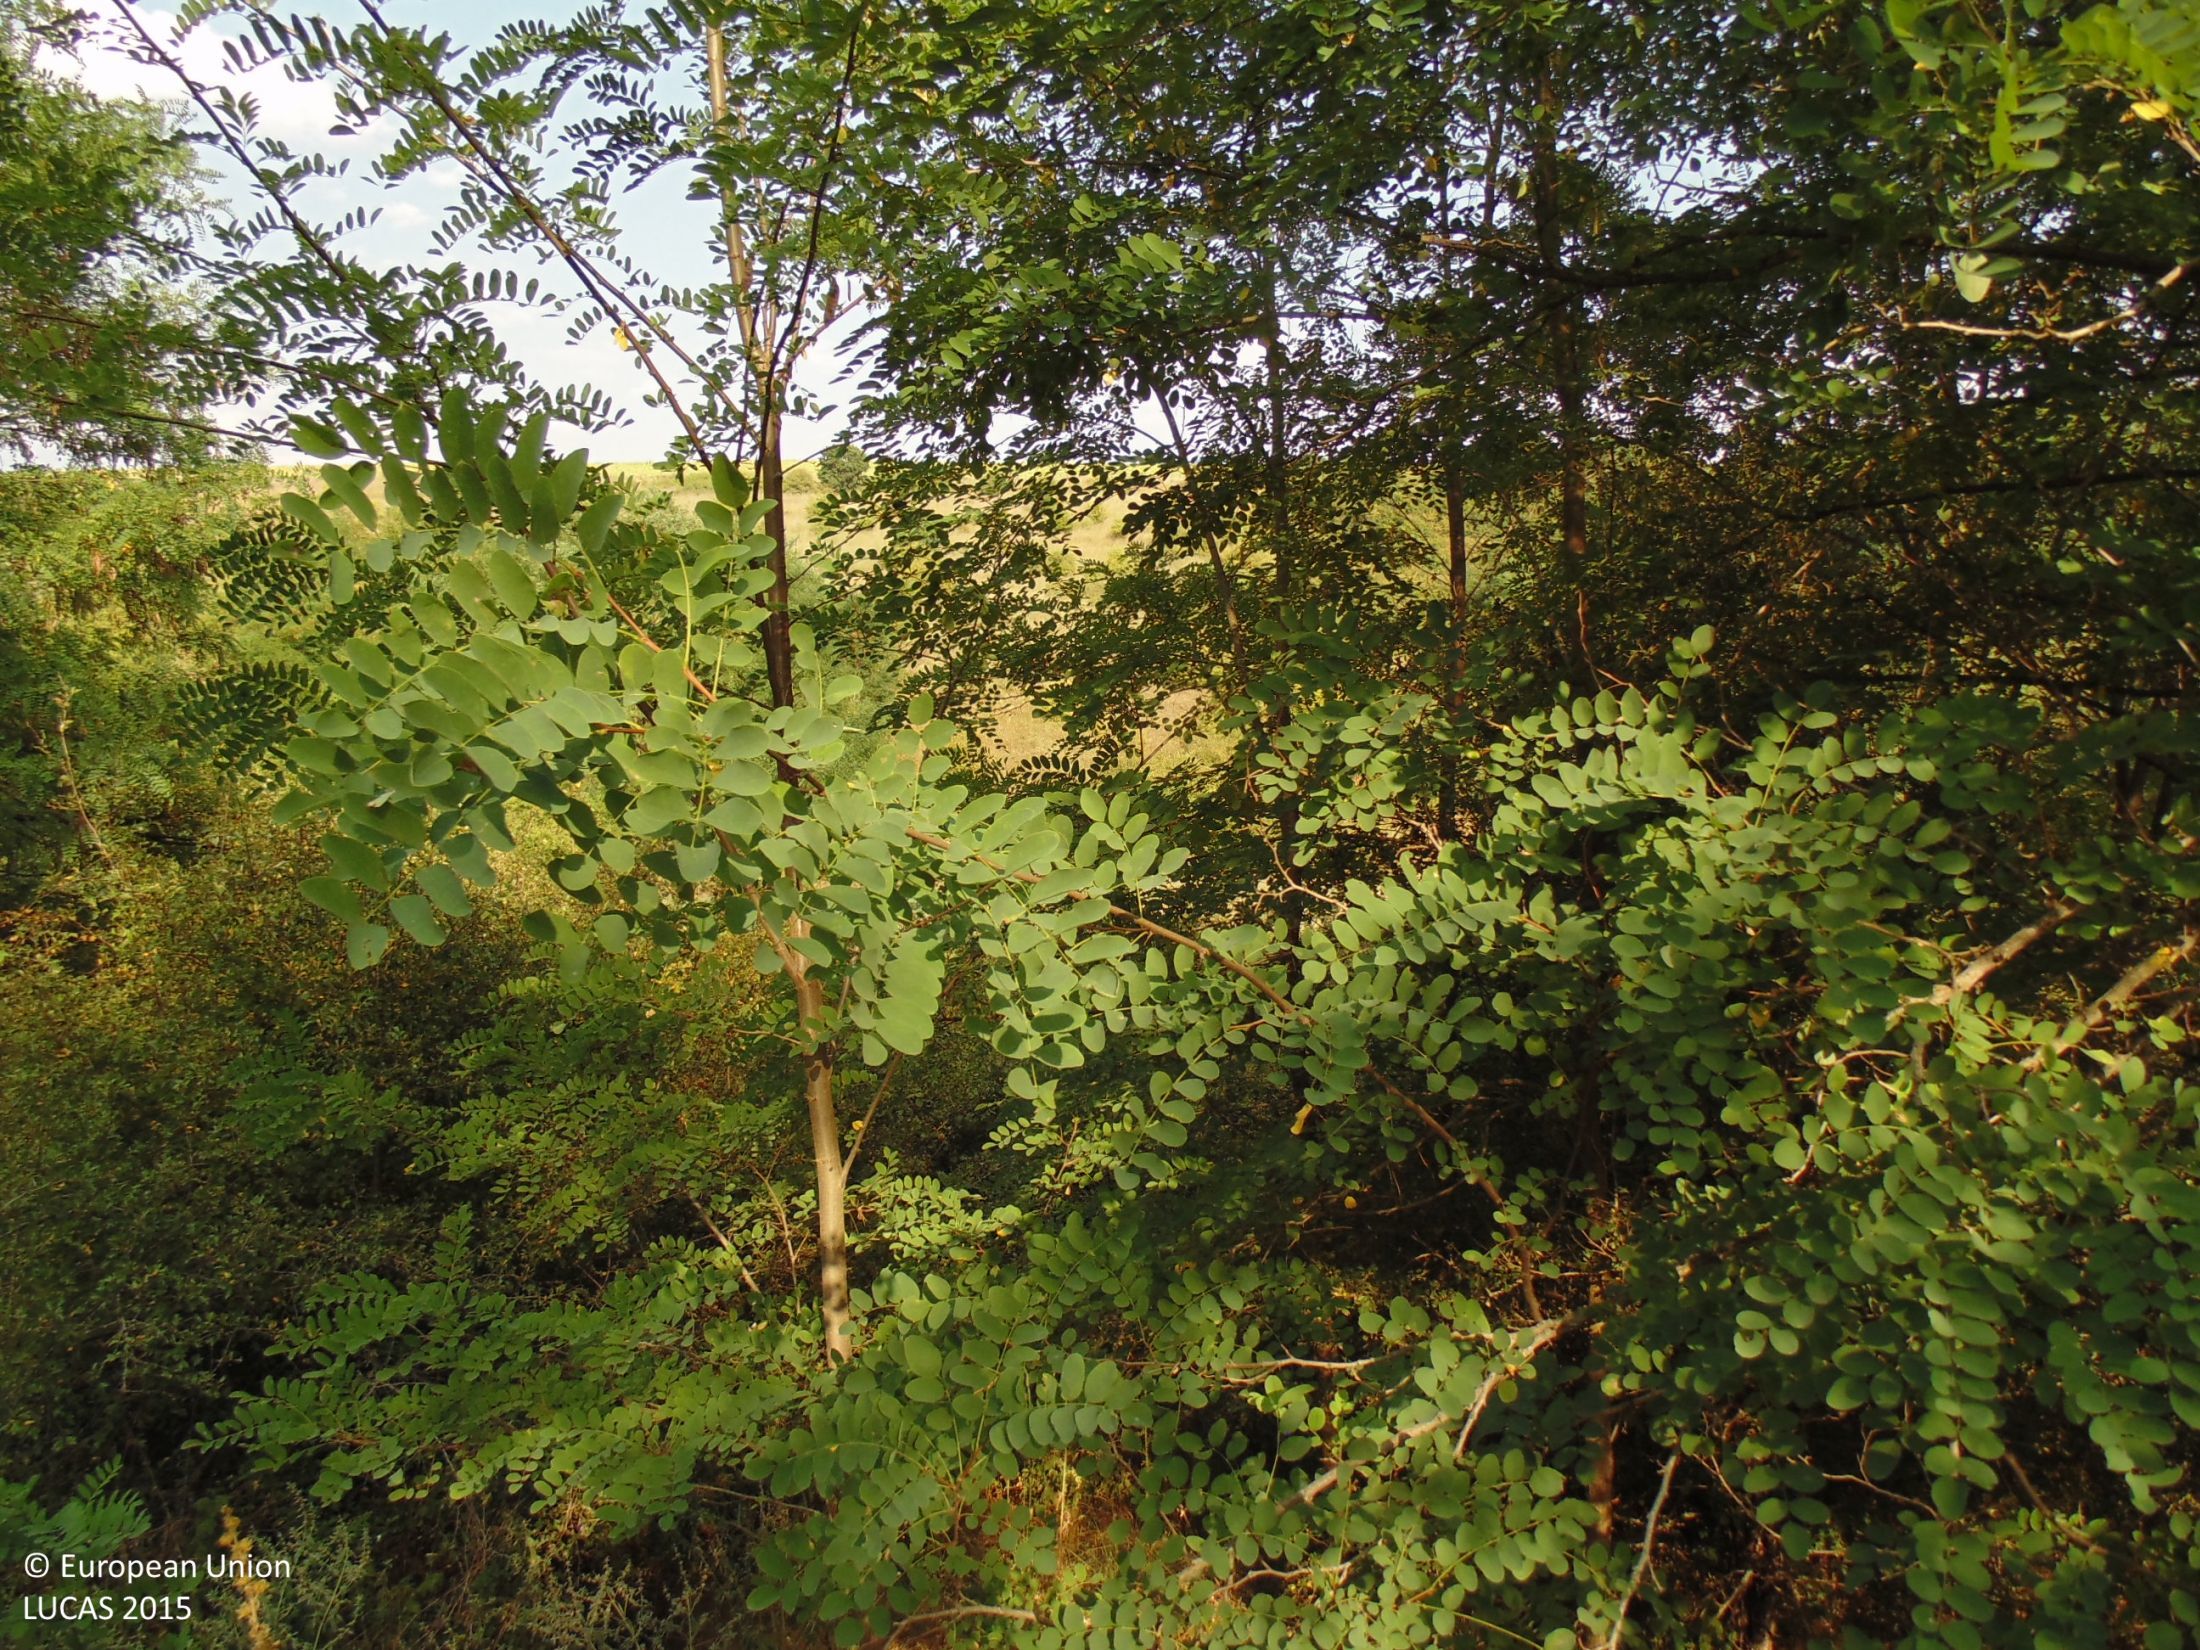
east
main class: Woodland
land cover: Broadleaved woodland
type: mesophytic deciduous forest
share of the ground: 50 - 75 %
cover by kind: broadleaved forest trees 70 %, shrubs 15 %, herbaceous plants 15 %
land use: Semi-natural and natural areas not in use
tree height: > 5 m
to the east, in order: Broadleaved woodland; Grassland with sparse tree/shrub cover; Broadleaved woodland; Grassland with sparse tree/shrub cover
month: August
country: BG
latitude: 43.9392
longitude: 27.6956
